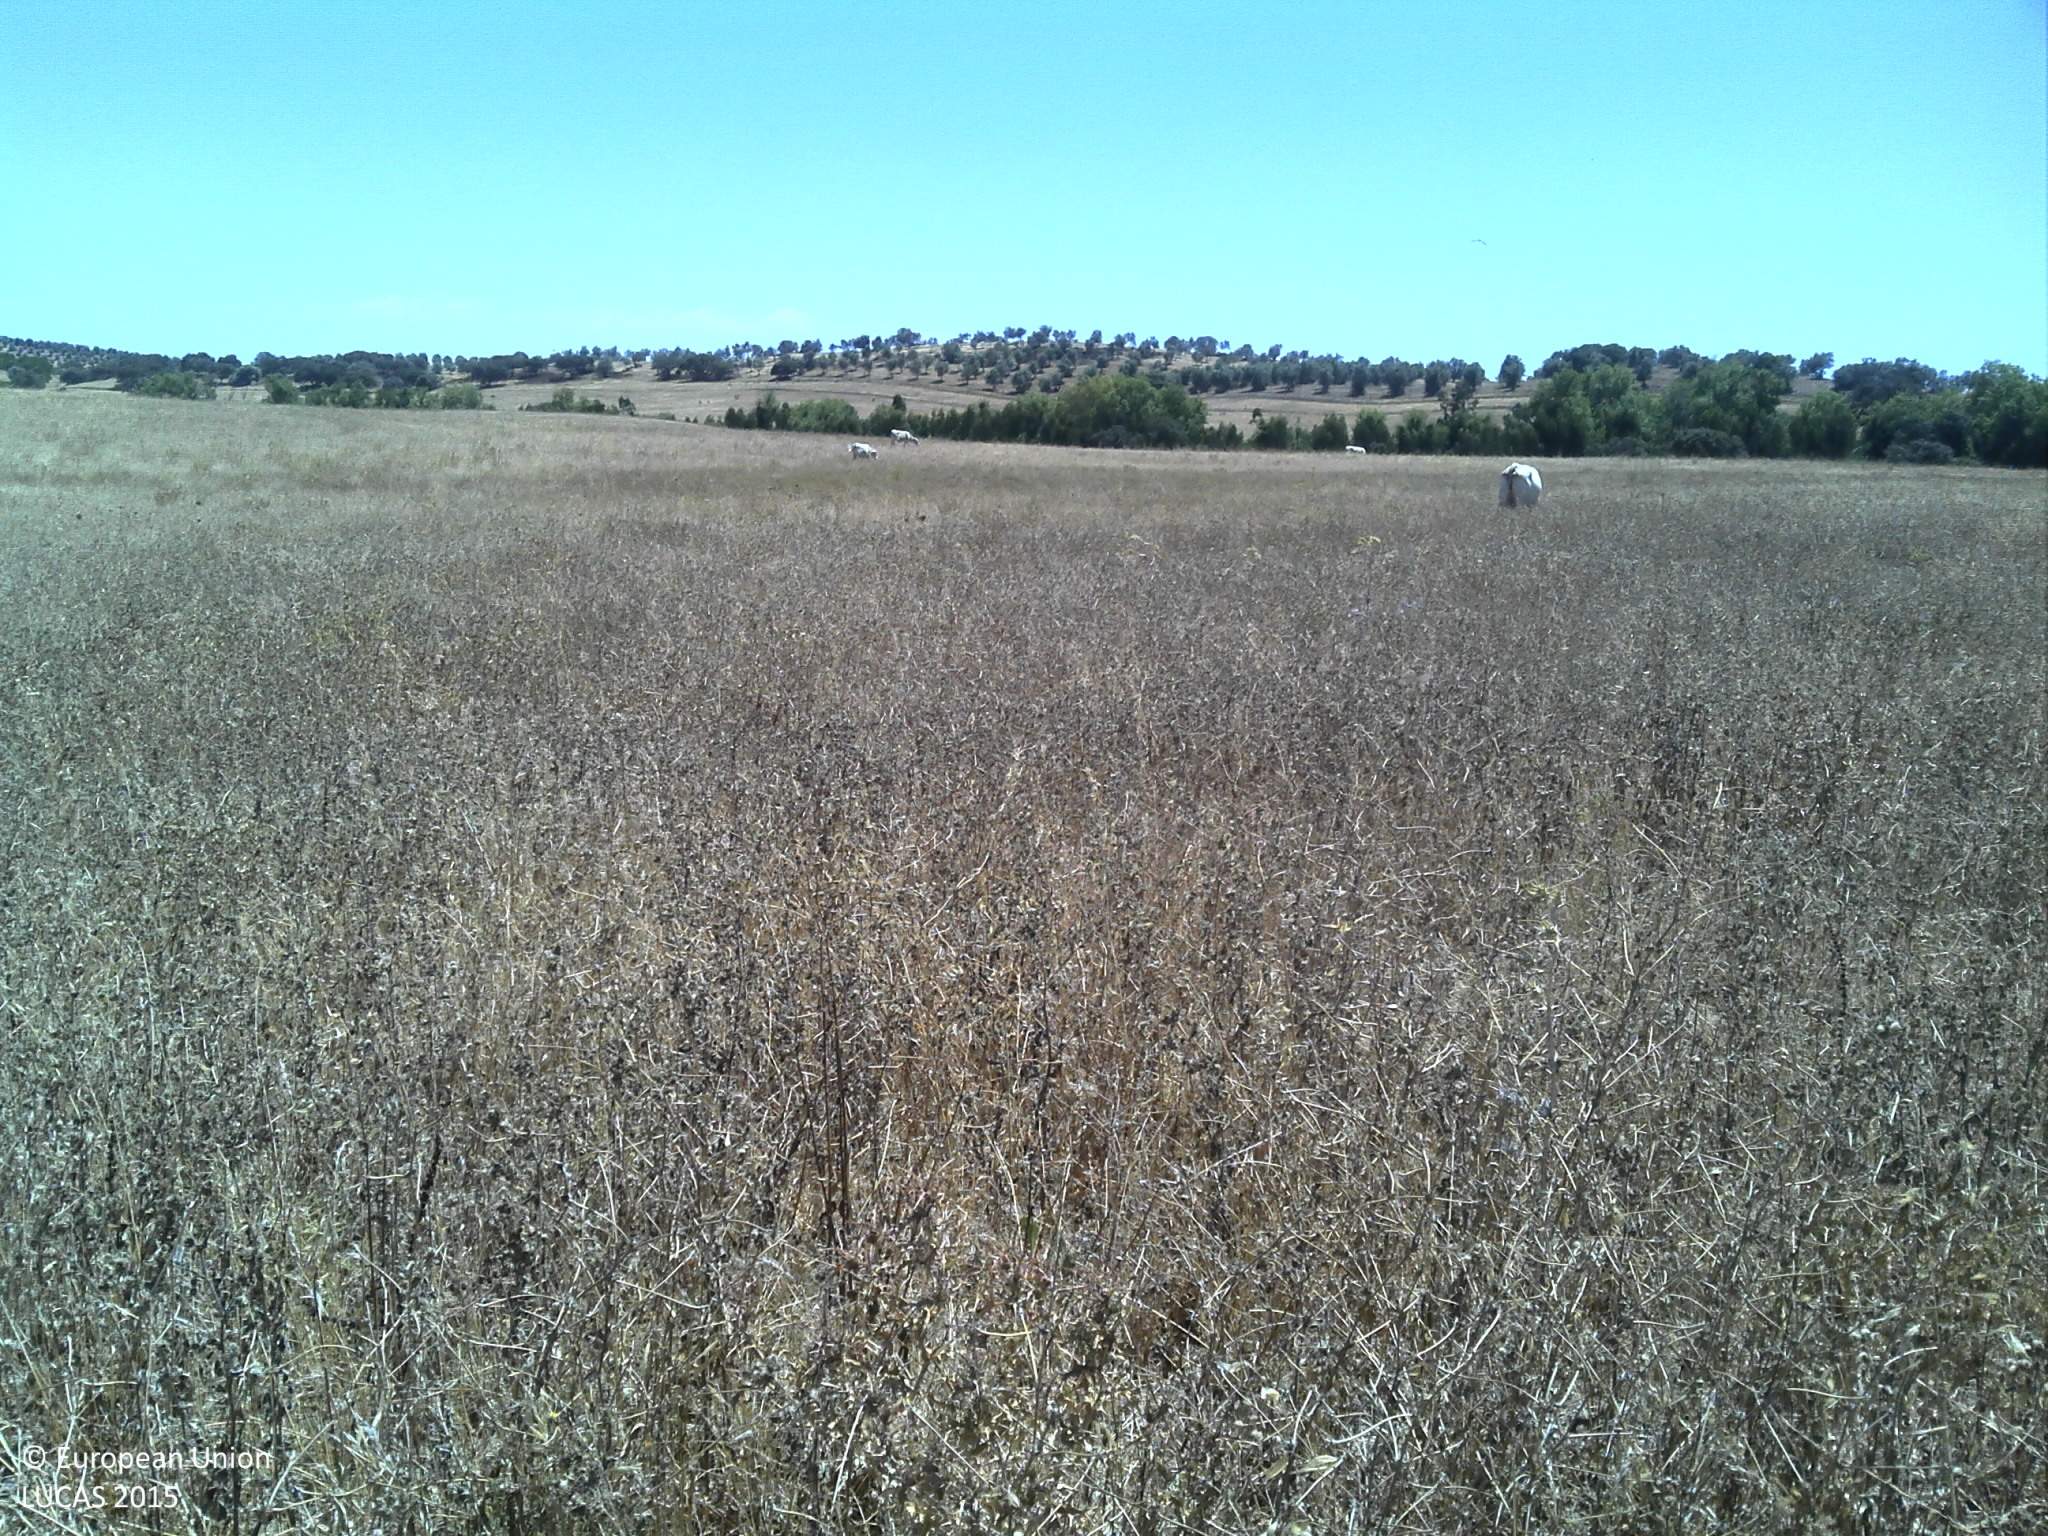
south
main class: Grassland
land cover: Grassland without tree/shrub cover
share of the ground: > 75 %
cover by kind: herbaceous plants 90 %, unconsolidated bare surface 10 %
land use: Agriculture (excluding fallow land and kitchen gardens)
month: July
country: PT
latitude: 38.0374
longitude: -8.0693
